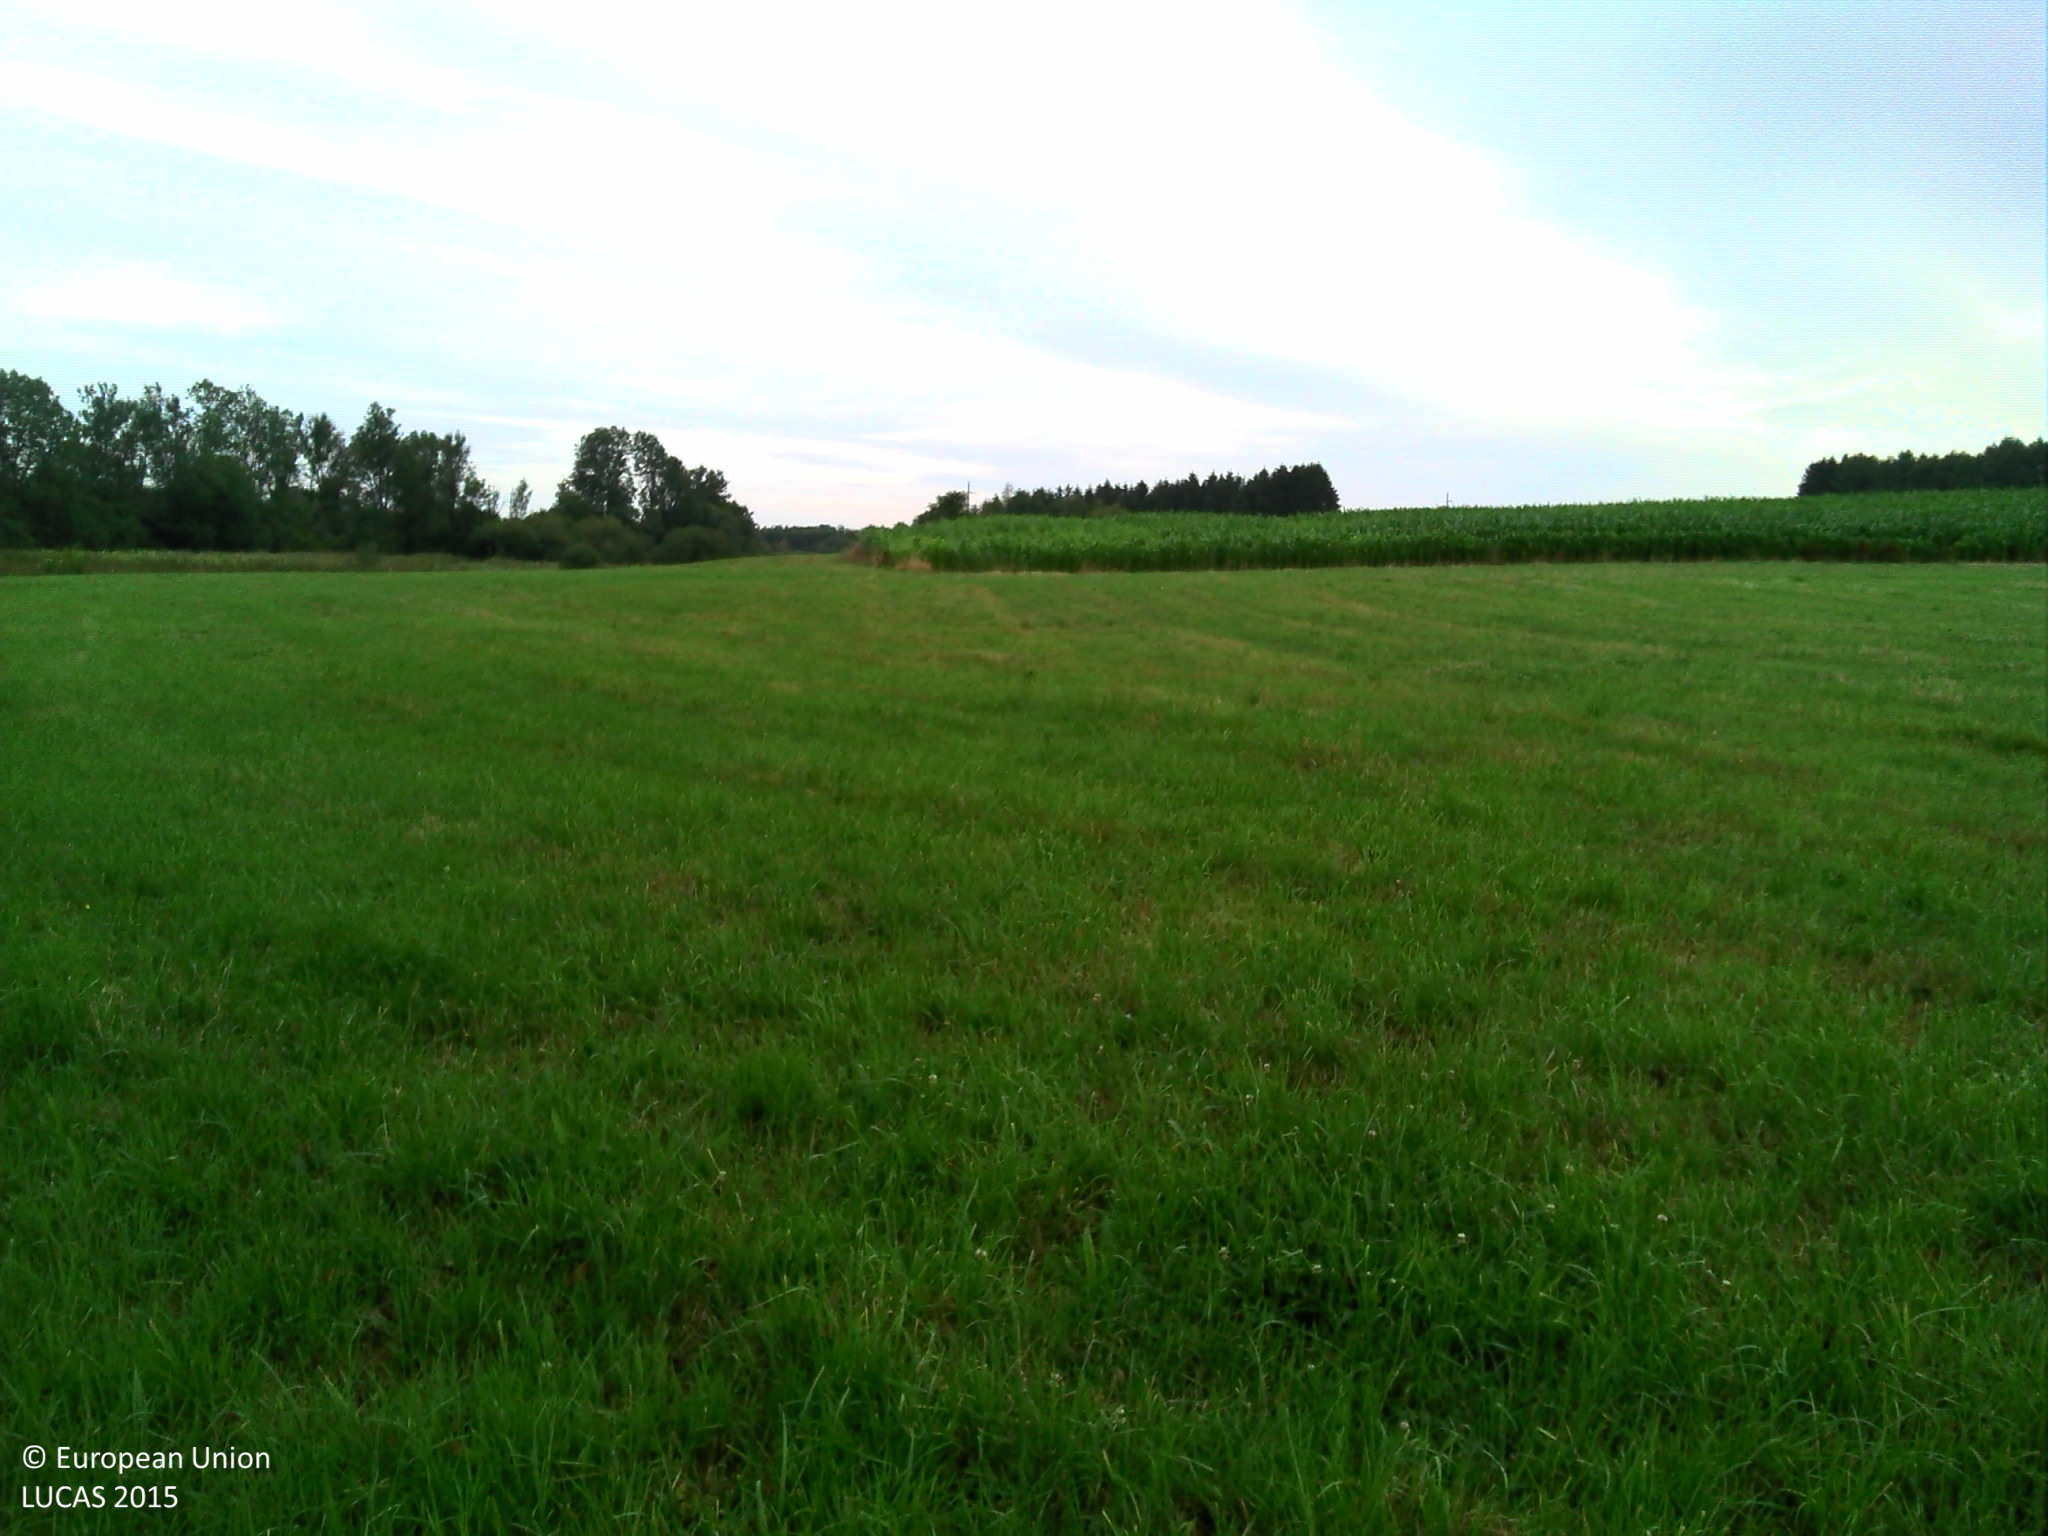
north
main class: Grassland
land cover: Grassland without tree/shrub cover
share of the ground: > 75 %
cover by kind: herbaceous plants 100 %
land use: Agriculture (excluding fallow land and kitchen gardens)
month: July
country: BE
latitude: 49.6885
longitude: 5.6878
